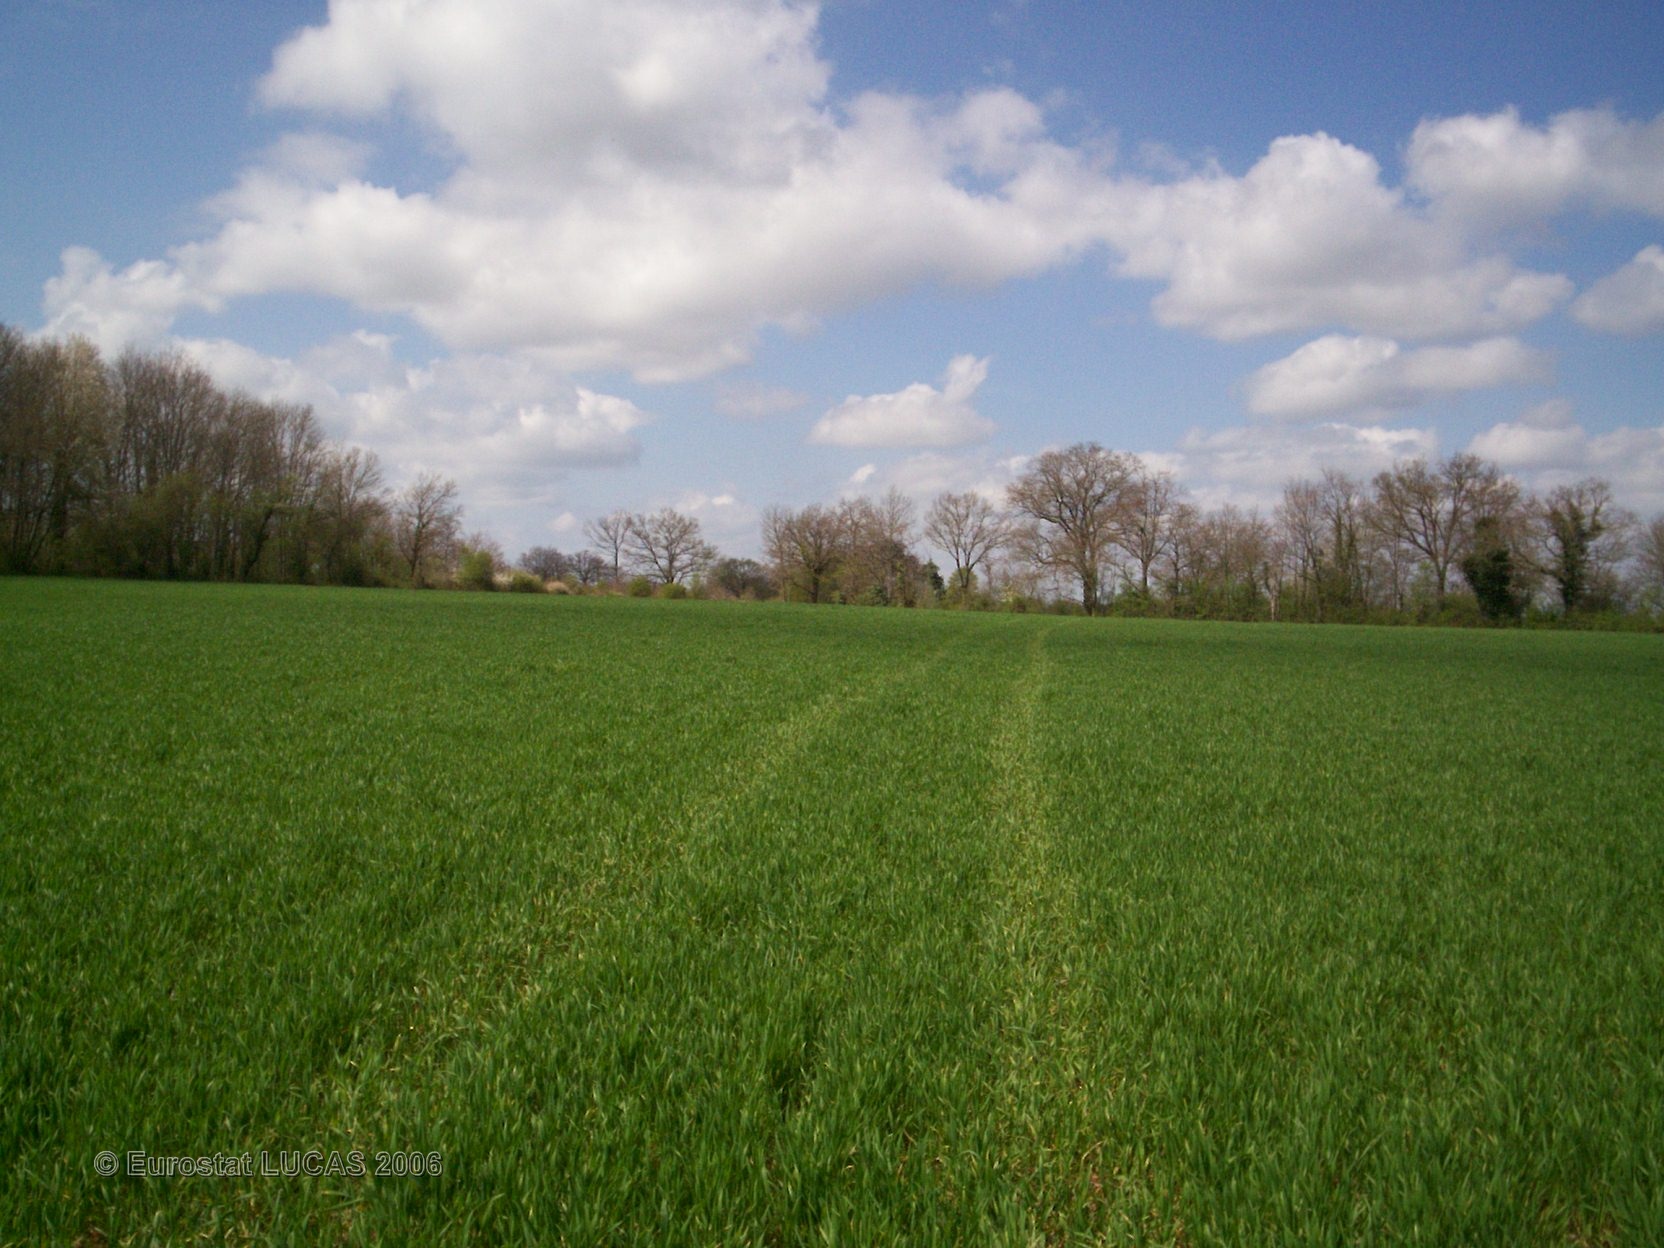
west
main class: Cropland
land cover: Common wheat
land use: Agriculture (excluding fallow land and kitchen gardens)
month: April
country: FR
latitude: 46.2118
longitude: 0.6393
